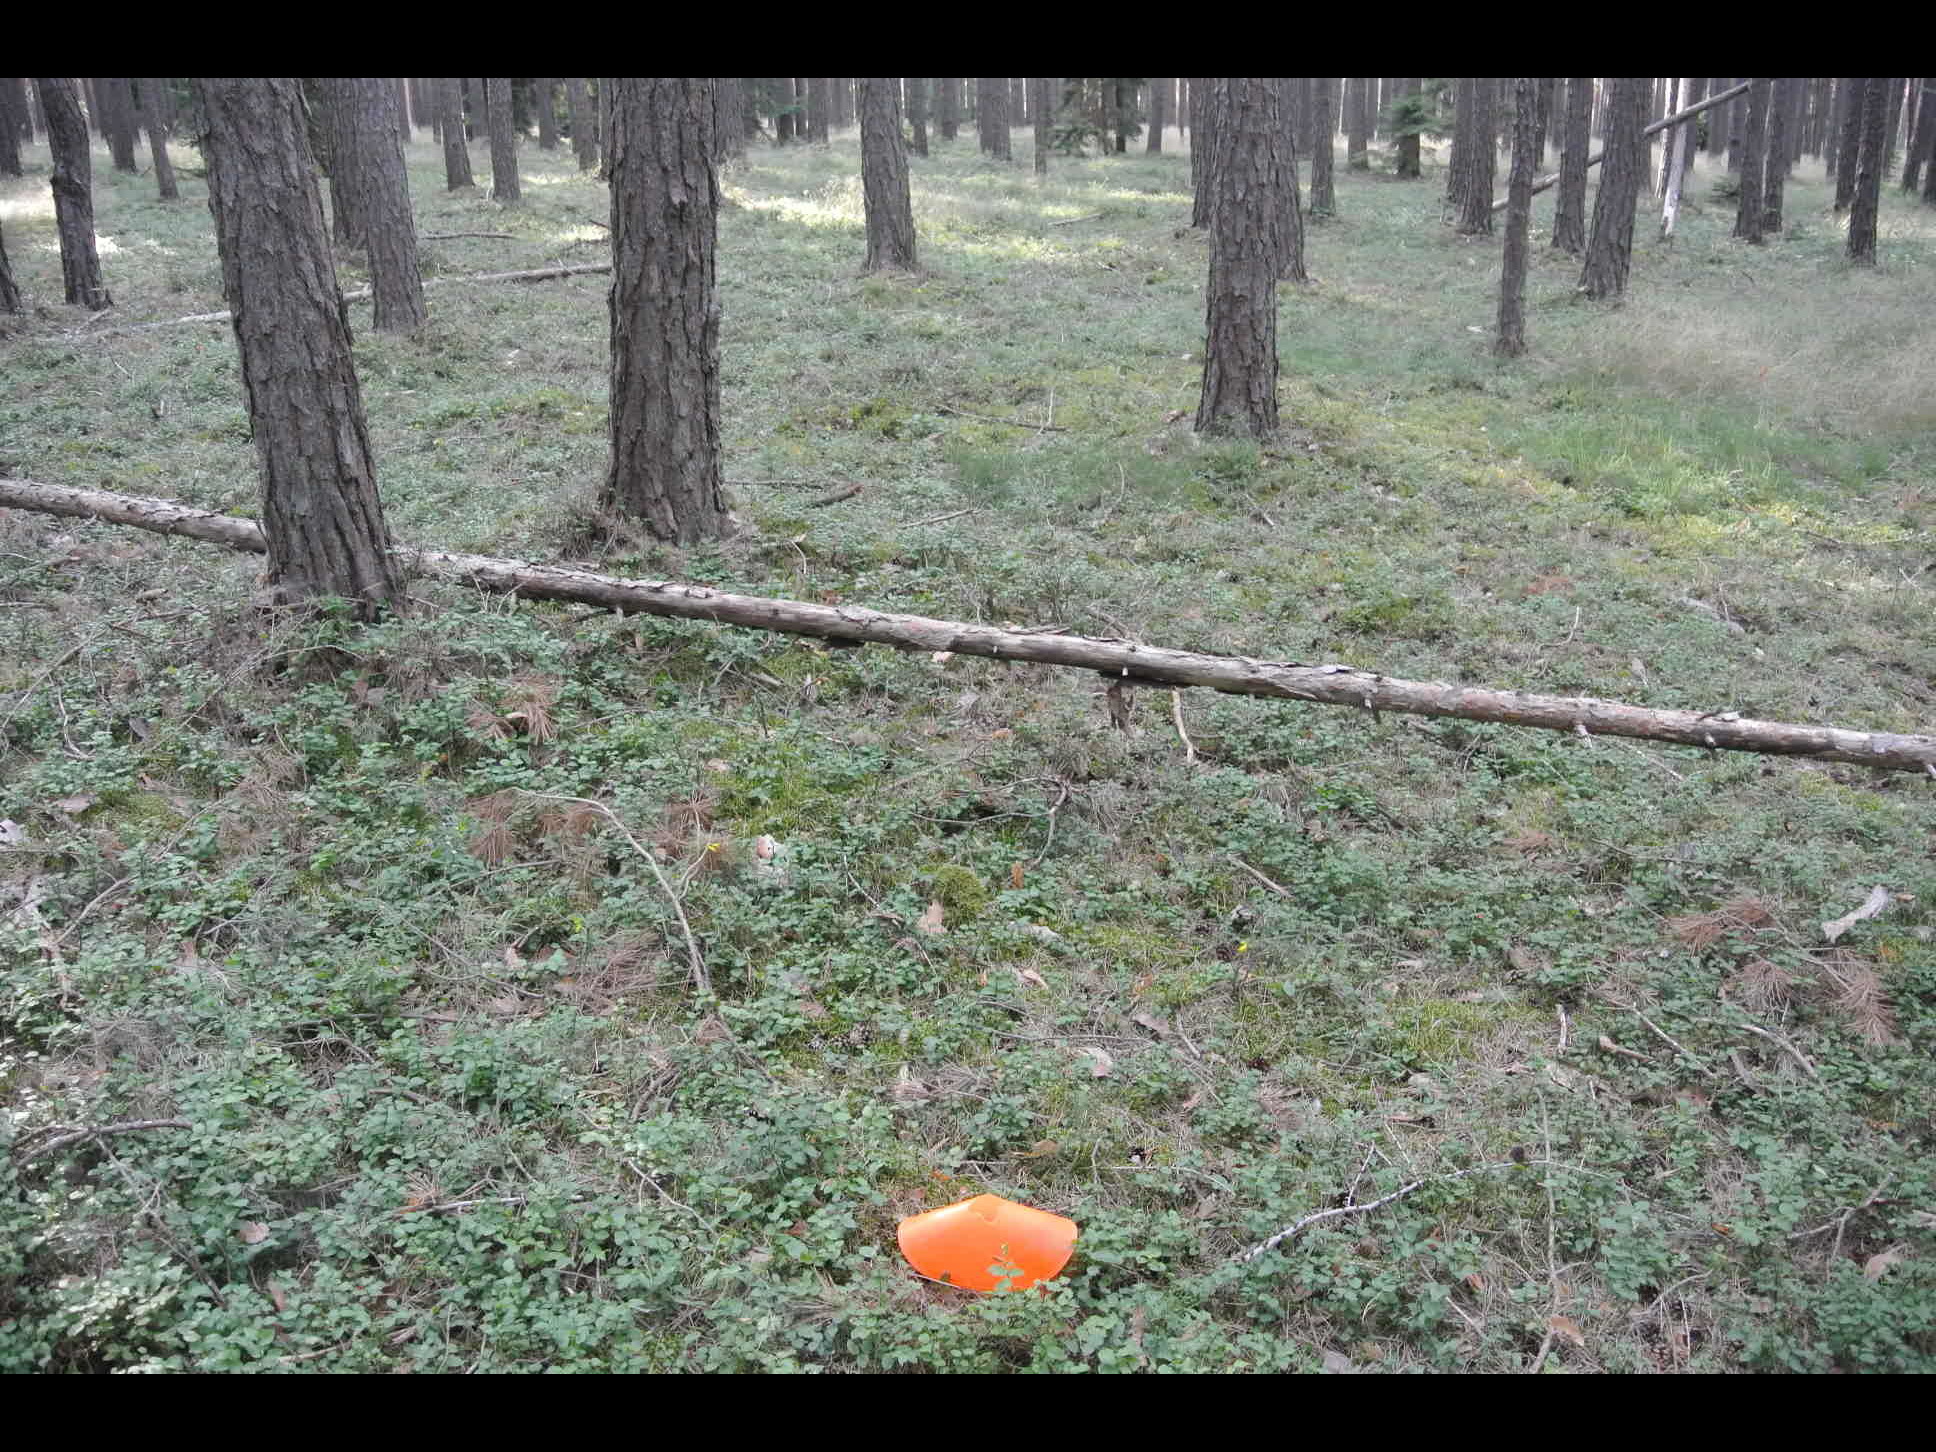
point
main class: Woodland
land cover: Pine dominated coniferous woodland
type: alpine coniferous forest
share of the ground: > 75 %
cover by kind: coniferous forest trees 100 %
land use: Forestry
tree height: > 5 m
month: July
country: AT
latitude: 47.6926
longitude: 16.1187
